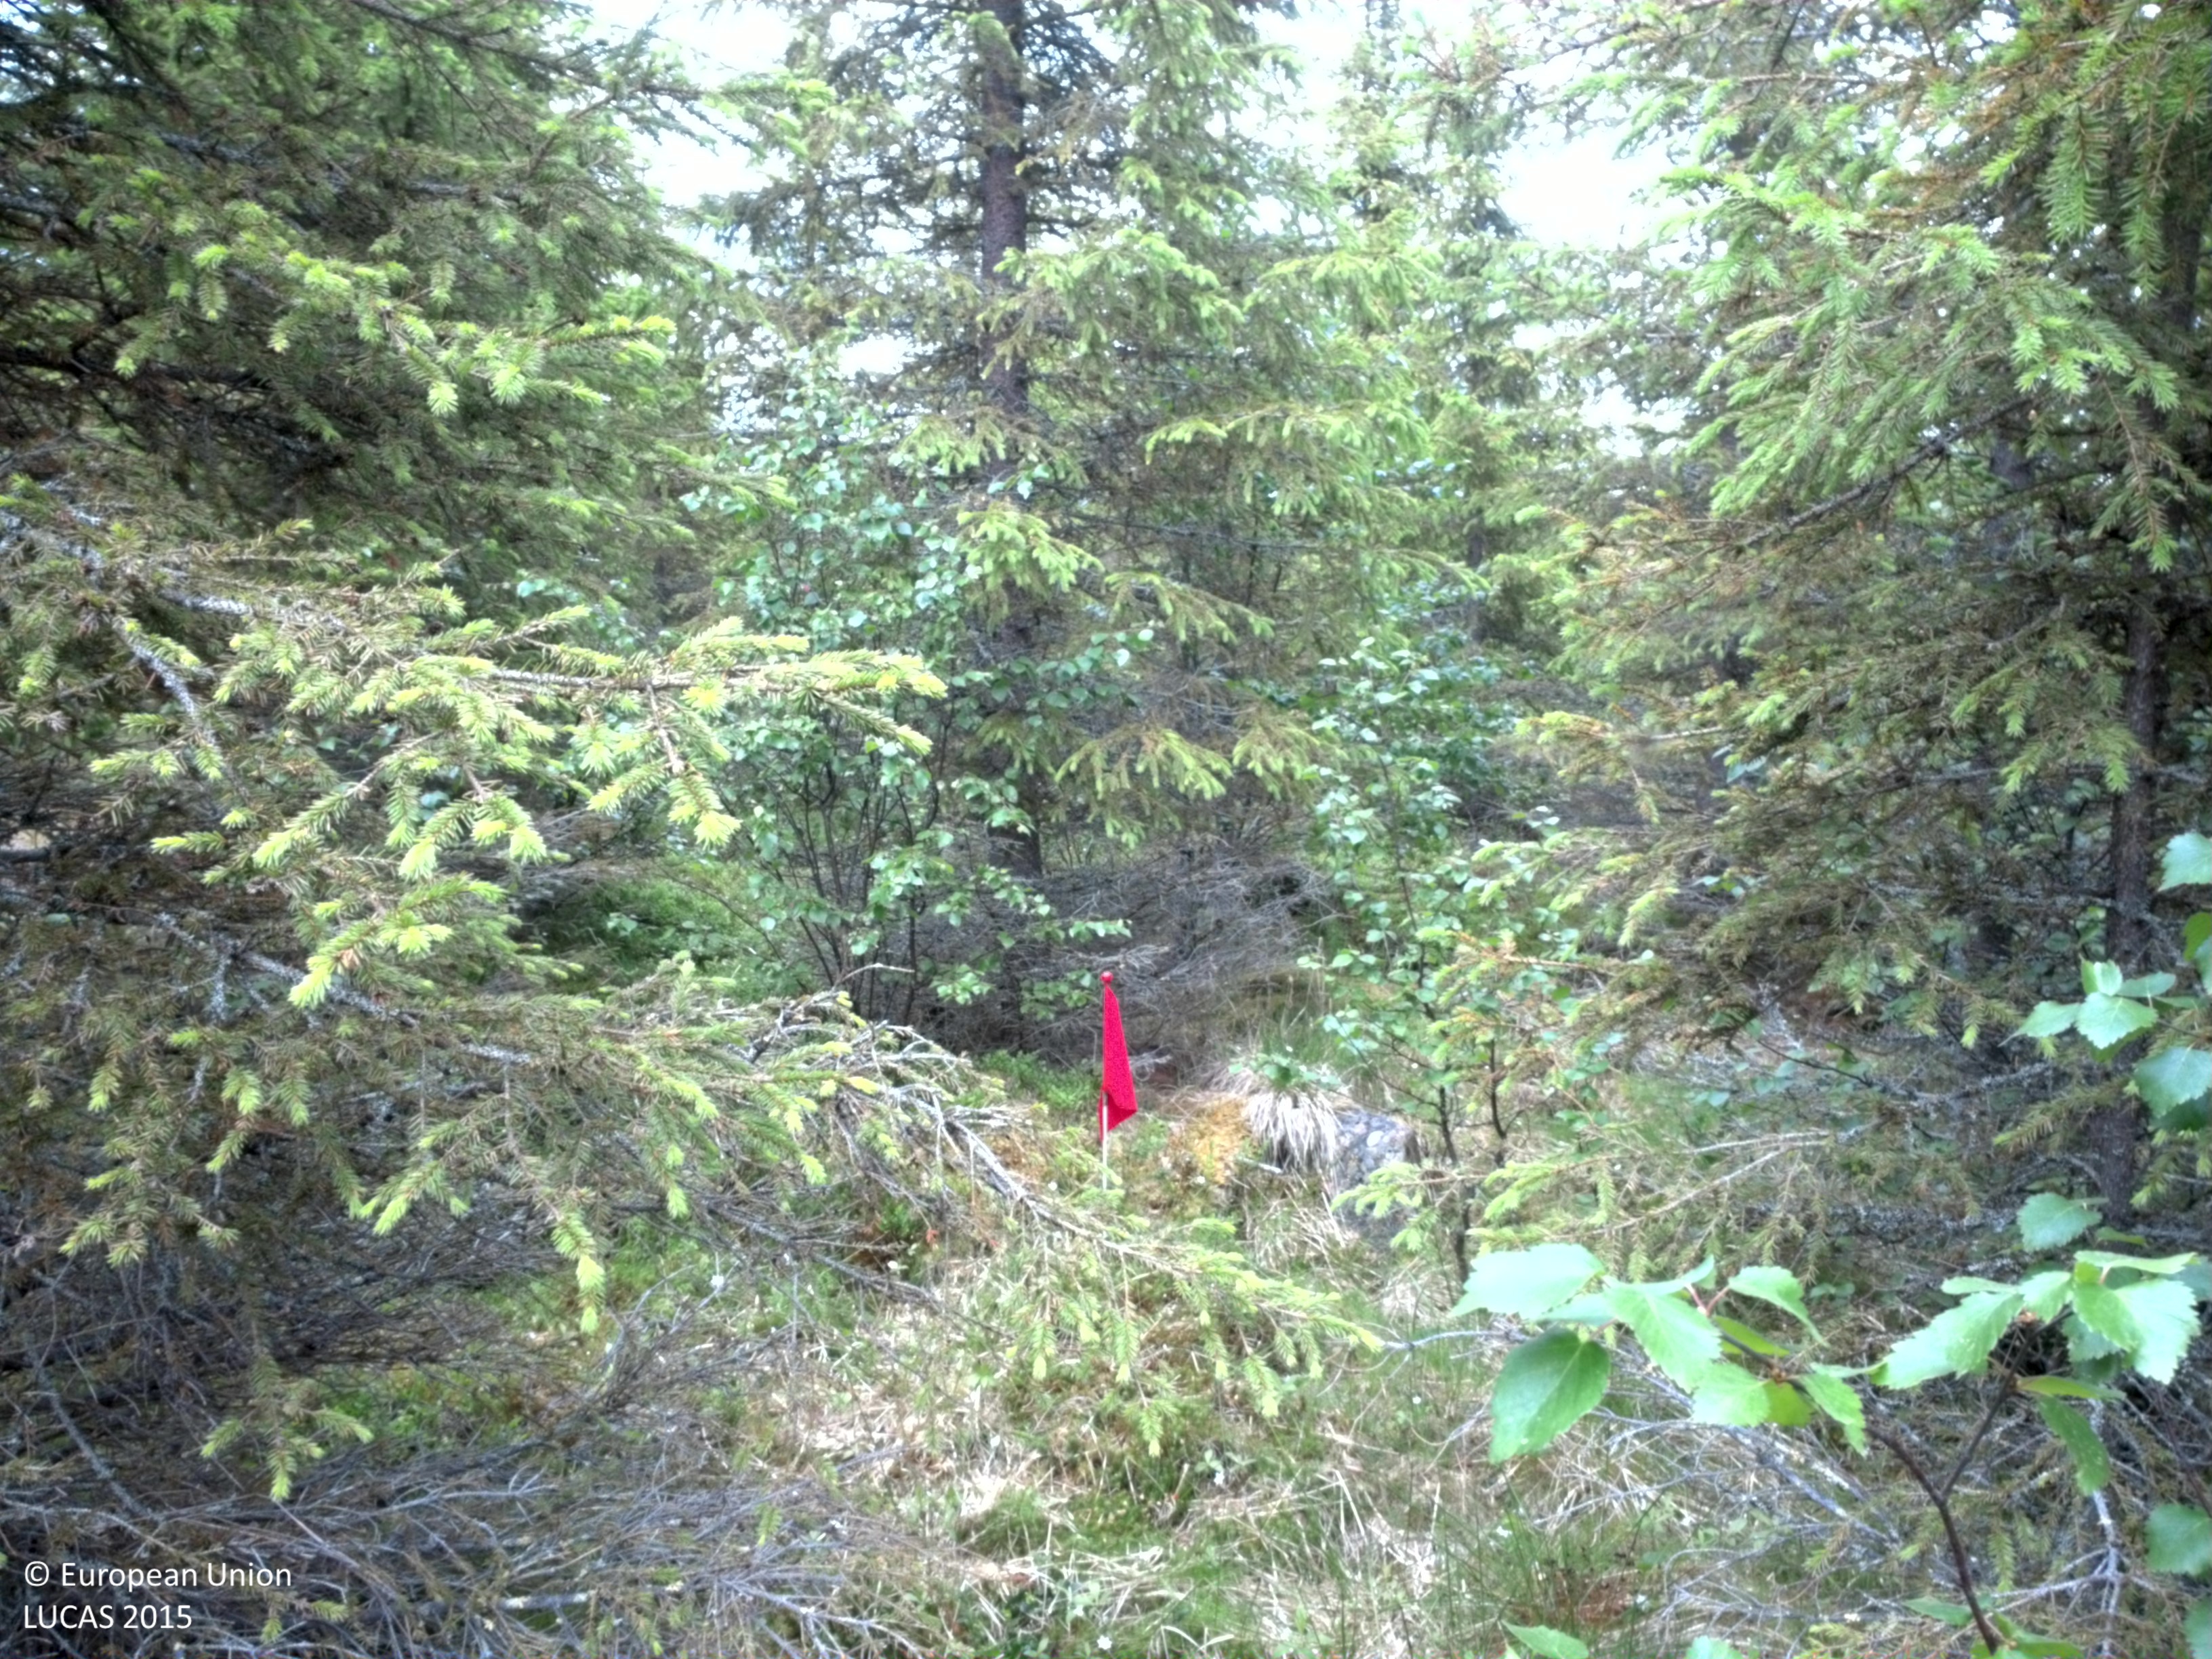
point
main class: Woodland
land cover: Spruce dominated mixed woodland
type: boreal forest
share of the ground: 50 - 75 %
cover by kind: coniferous forest trees 45 %, broadleaved forest trees 15 %, shrubs 15 %, herbaceous plants 15 %, lichens and mosses 10 %
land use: Forestry
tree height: > 5 m
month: July
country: SE
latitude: 64.4438
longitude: 18.1330
